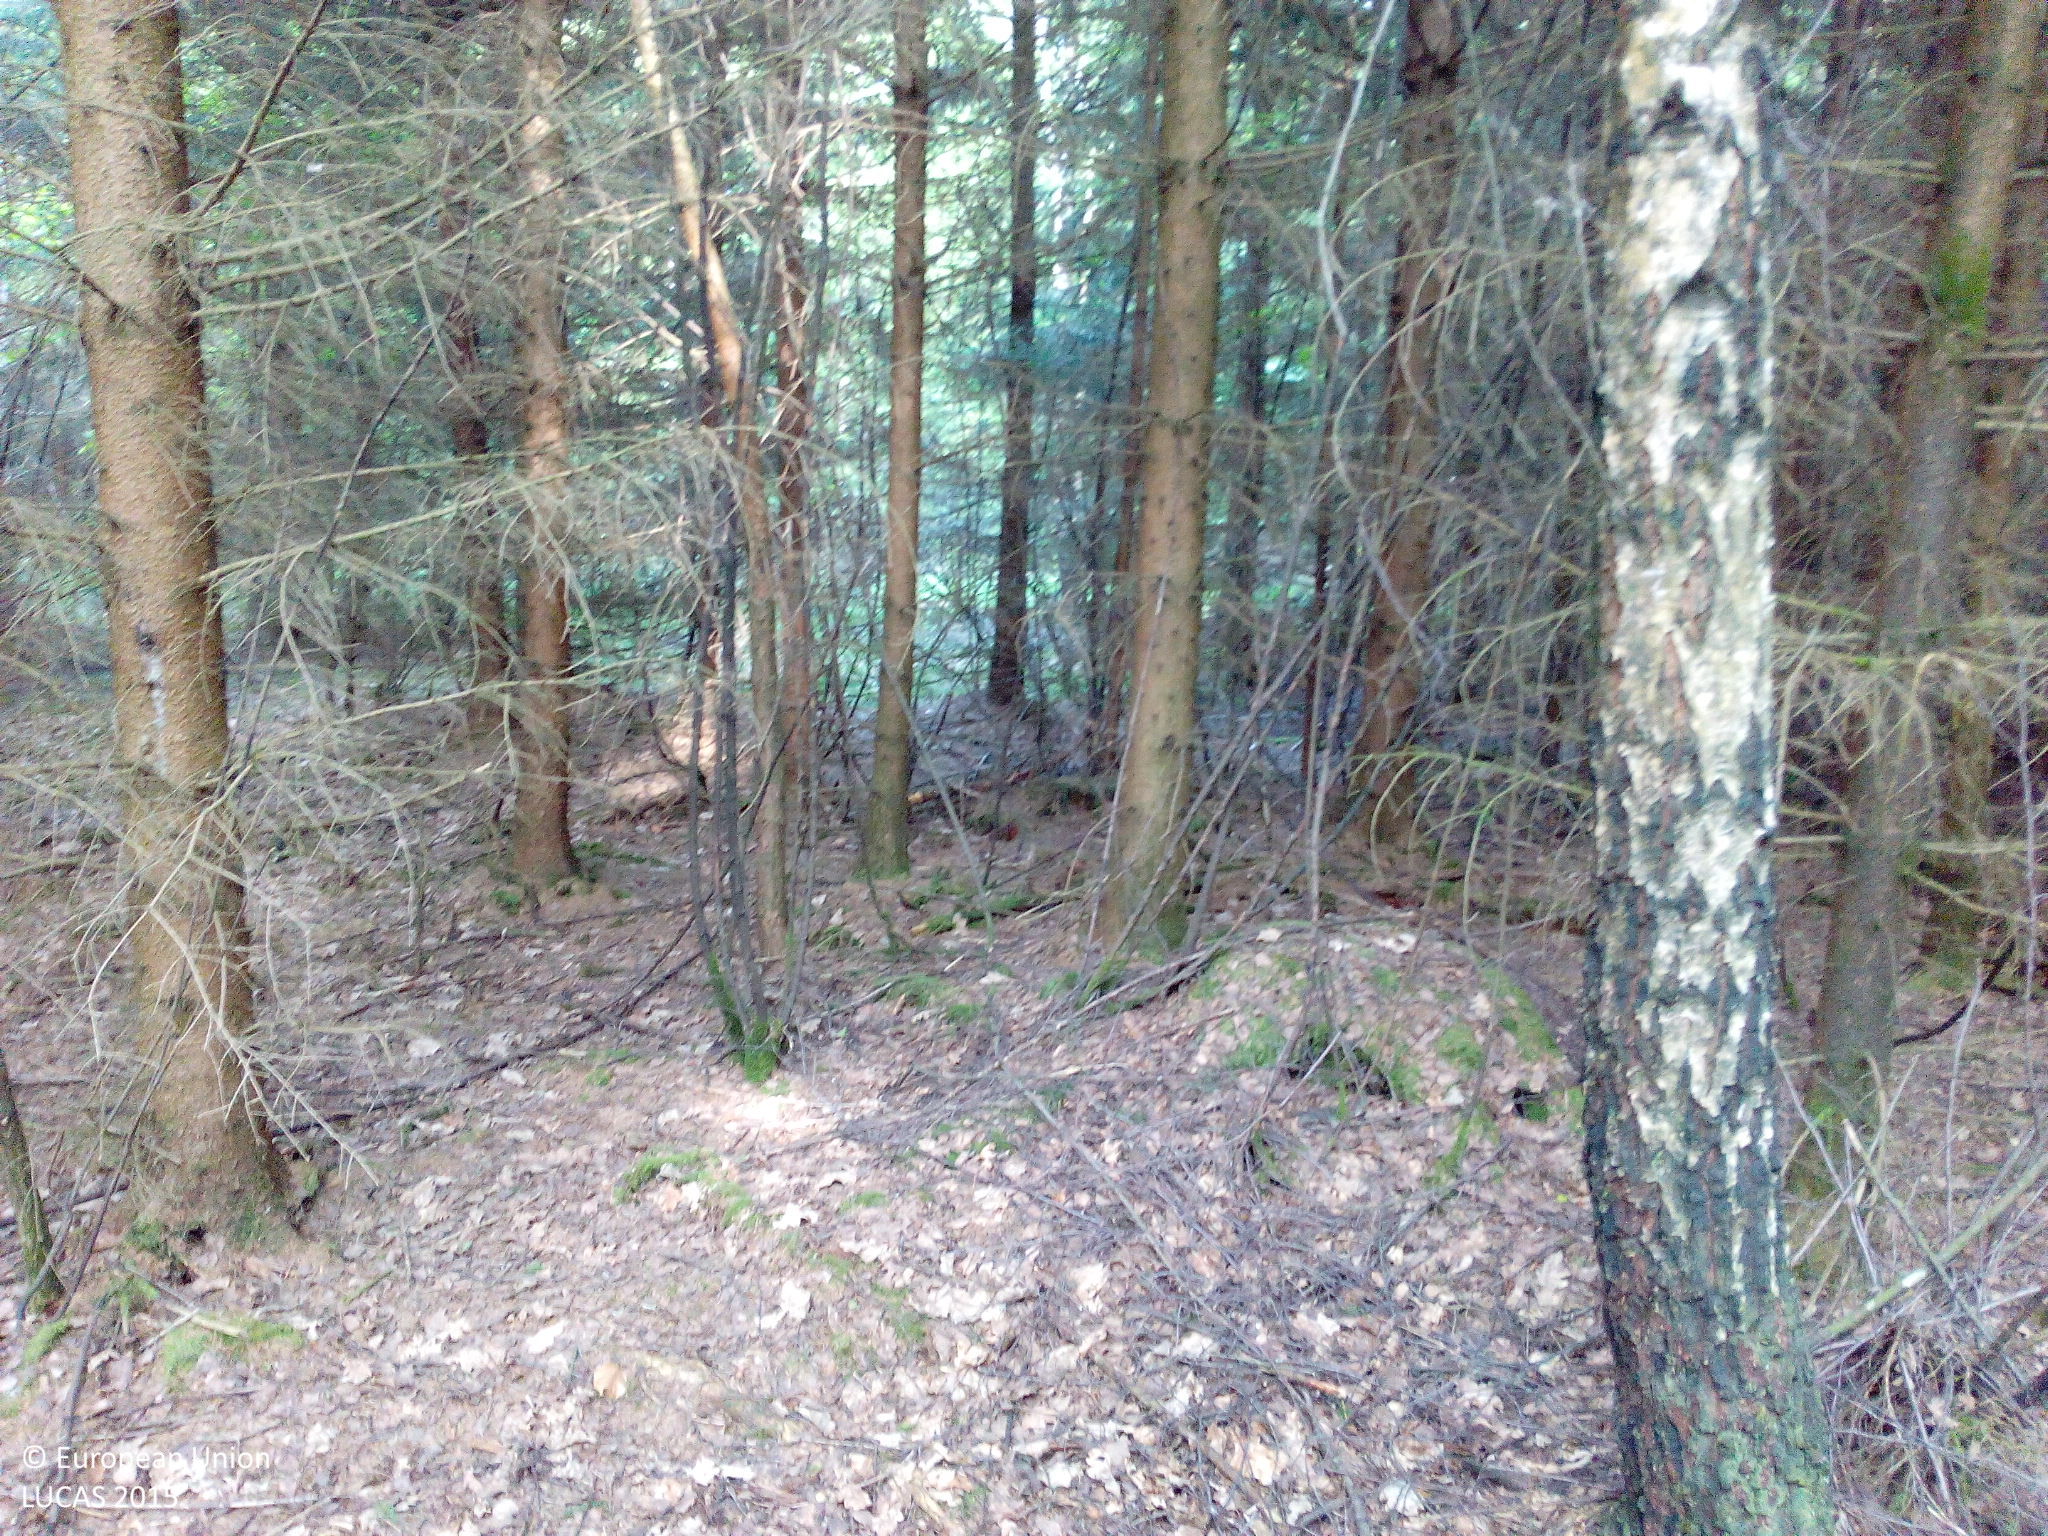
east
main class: Woodland
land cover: Spruce dominated mixed woodland
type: hemiboreal forest and nemoral coniferous forest and mixed broadleaved-coniferous forest
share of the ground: > 75 %
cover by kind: coniferous forest trees 75 %, broadleaved forest trees 25 %
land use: Forestry
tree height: > 5 m
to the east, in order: Spruce dominated mixed woodland; Tracks; Spruce dominated mixed woodland; Tracks; Spruce dominated coniferous woodland; Tracks; Spruce dominated coniferous woodland; Tracks; Spruce dominated coniferous woodland; Tracks; Spruce dominated coniferous woodland; Broadleaved woodland
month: May
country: DE
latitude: 49.1585
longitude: 9.6299
